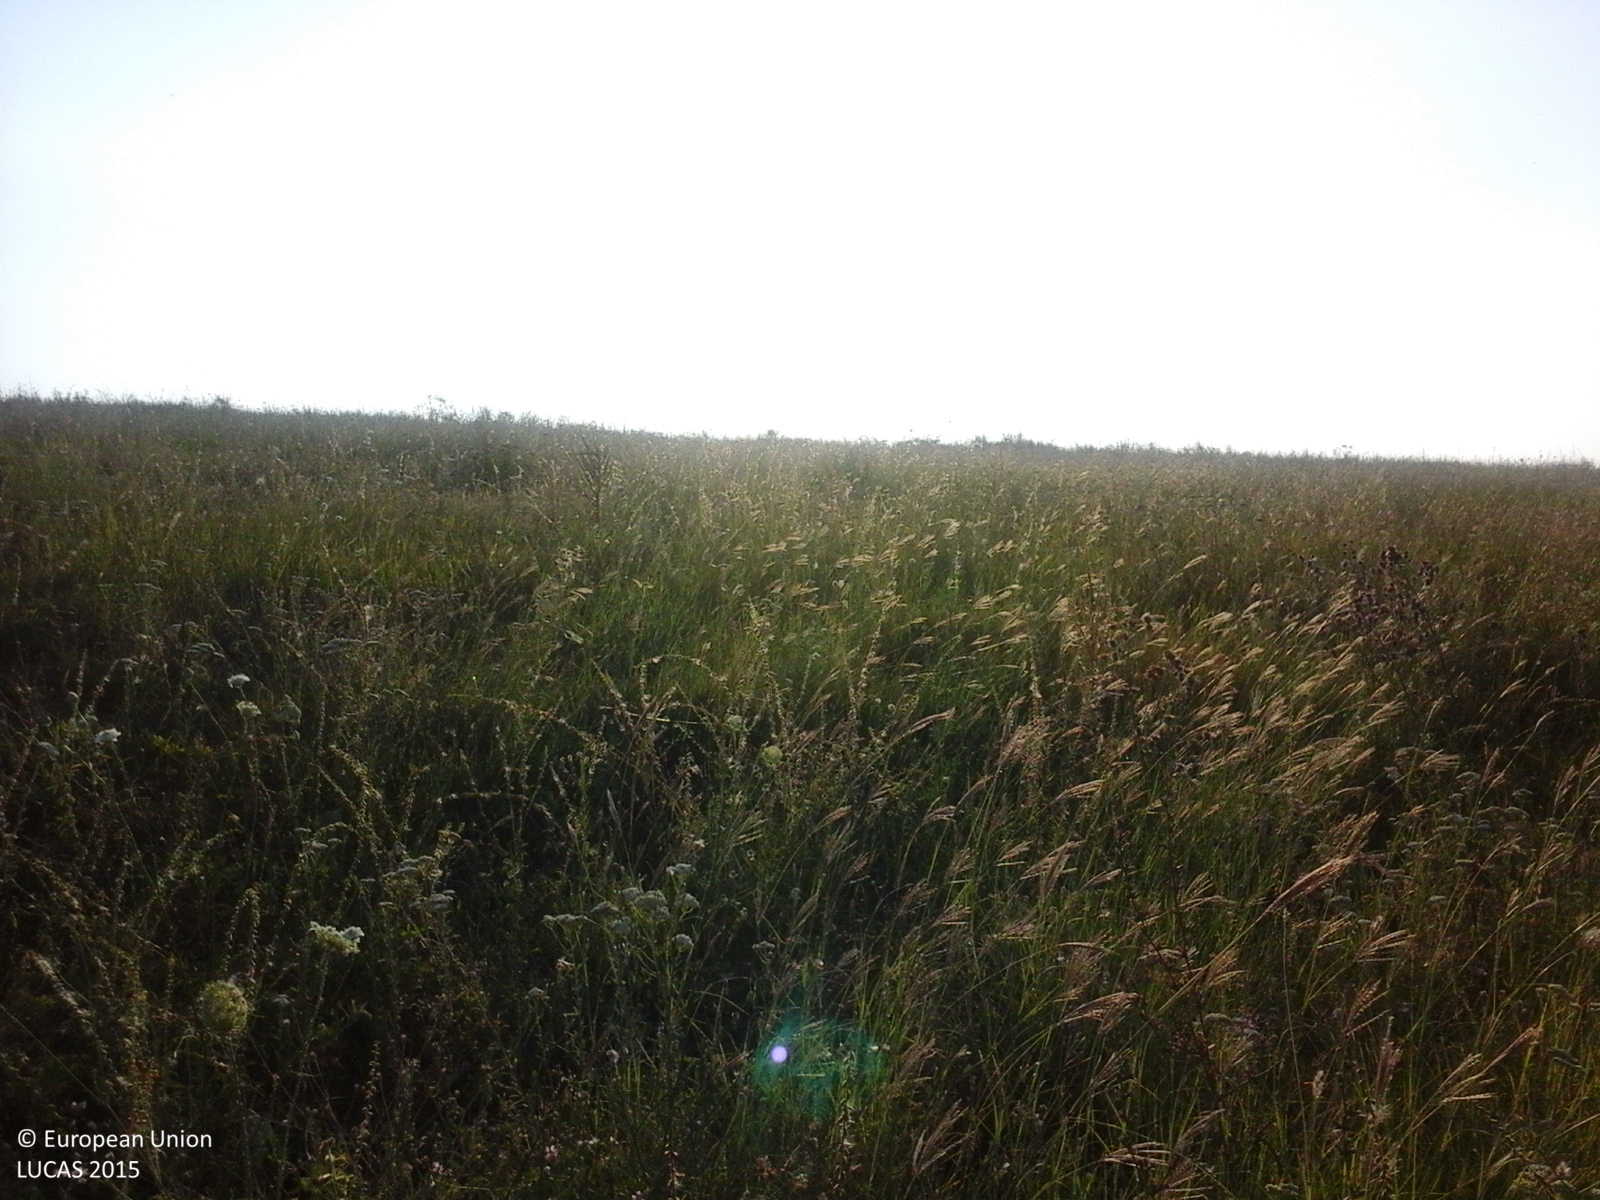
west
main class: Grassland
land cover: Grassland without tree/shrub cover
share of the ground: > 75 %
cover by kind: herbaceous plants 100 %
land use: Agriculture (excluding fallow land and kitchen gardens)
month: July
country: RO
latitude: 46.4217
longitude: 27.6142
